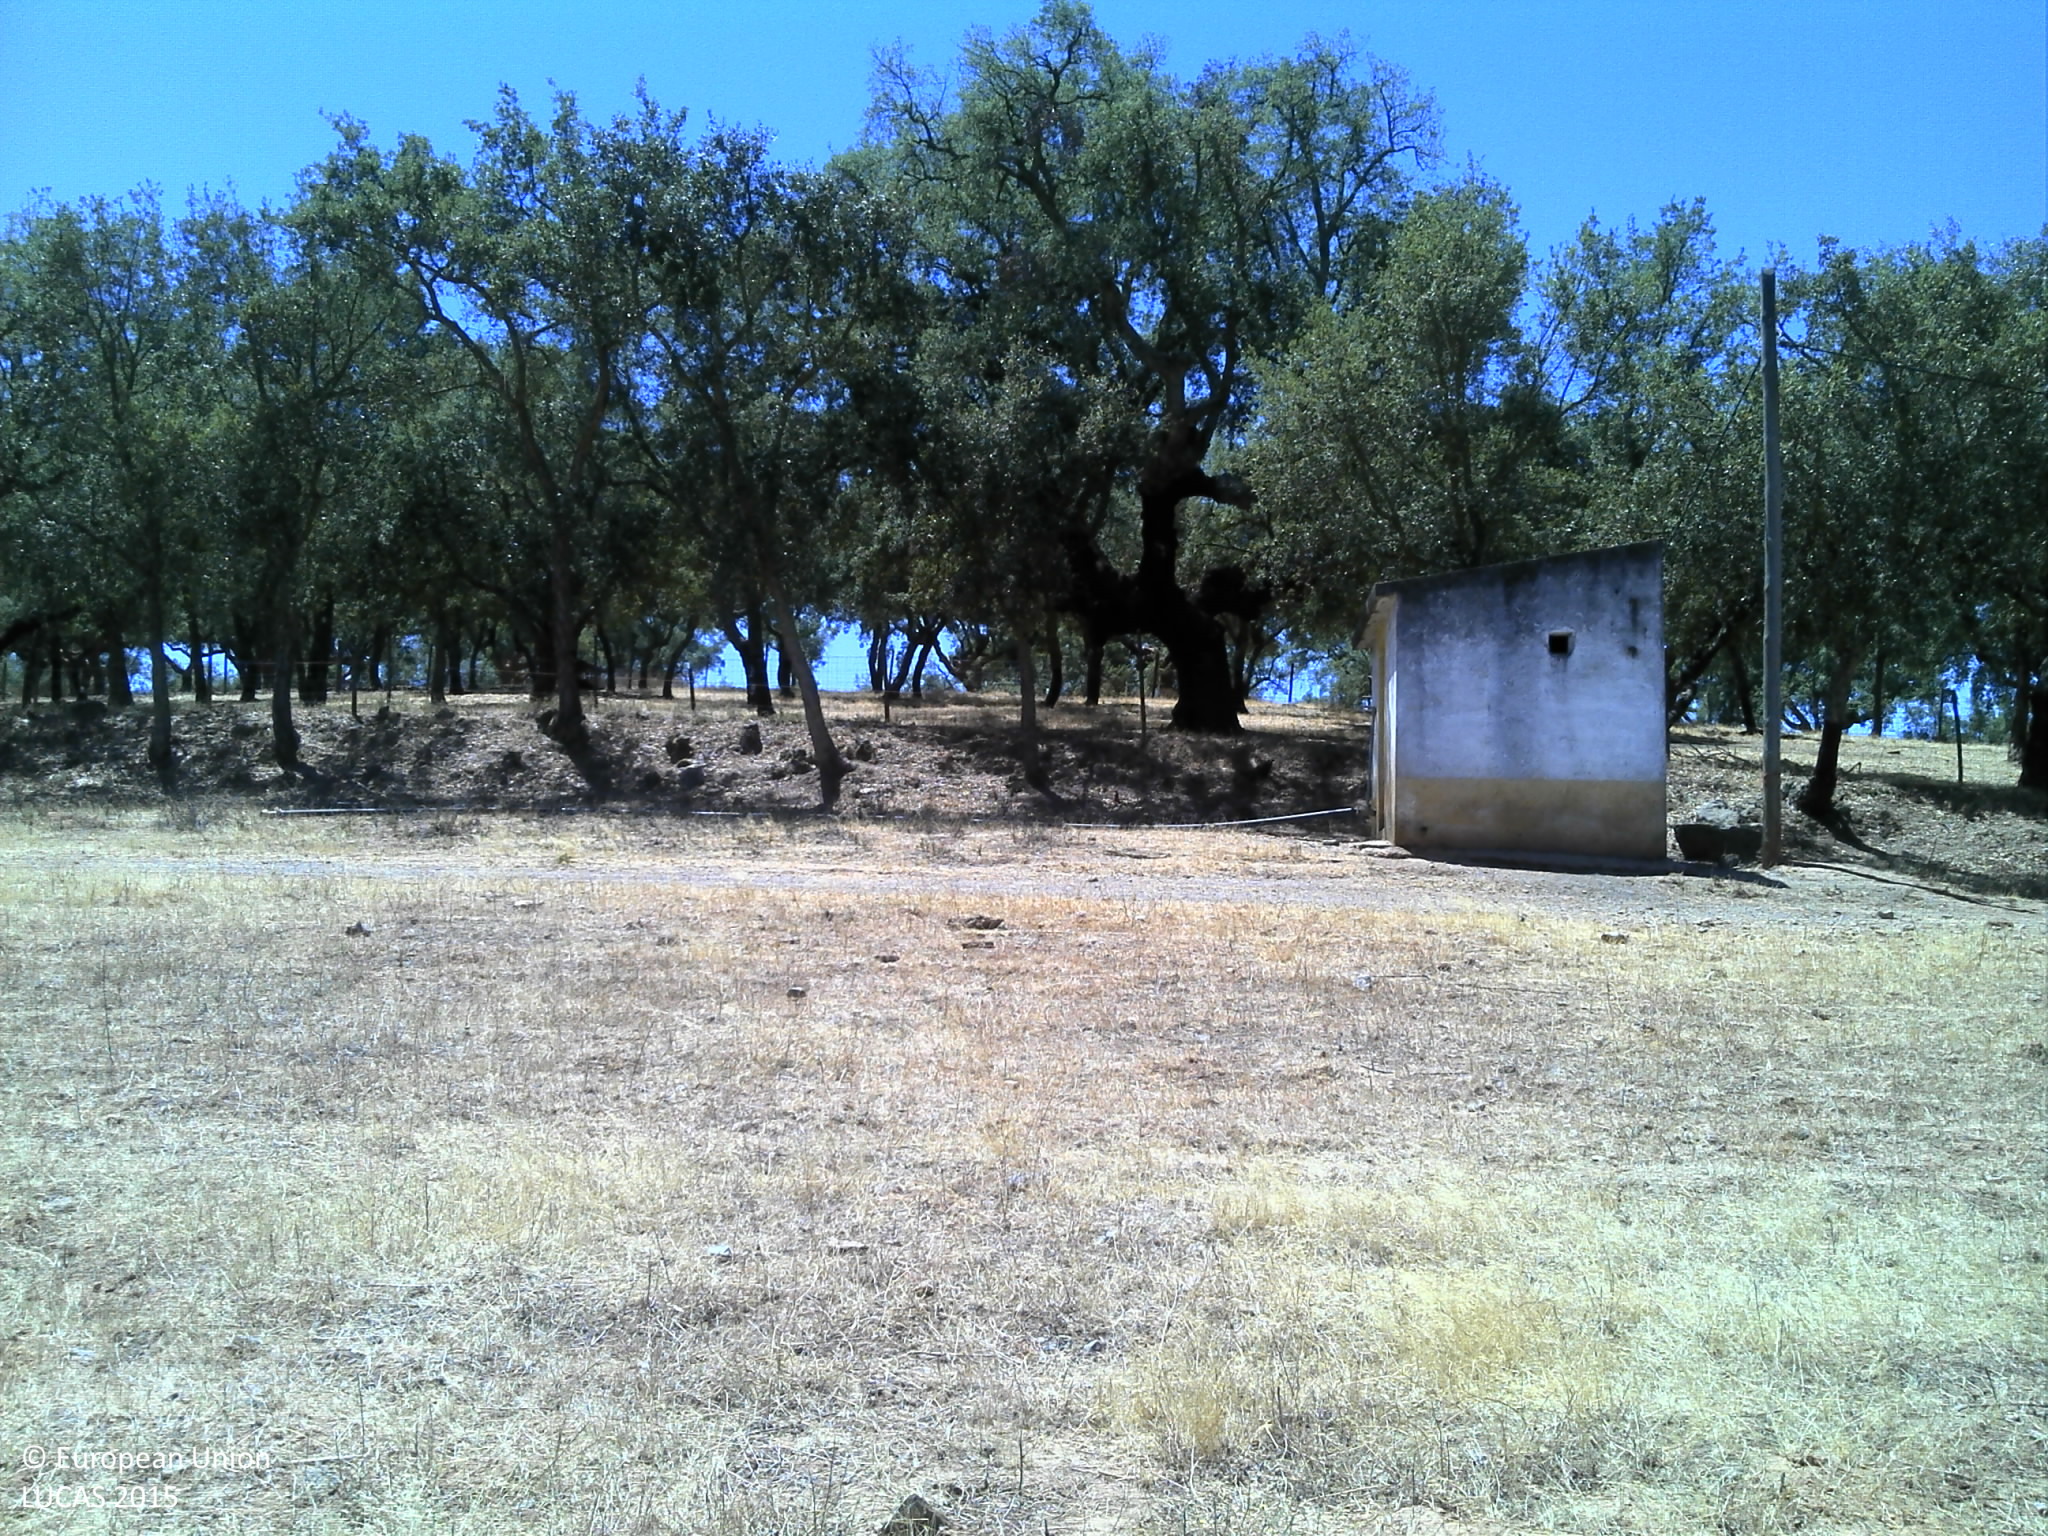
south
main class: Grassland
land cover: Grassland with sparse tree/shrub cover
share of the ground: 10 - 25 %
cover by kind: unconsolidated bare surface 70 %, herbaceous plants 25 %, broadleaved forest trees 5 %
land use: Agriculture (excluding fallow land and kitchen gardens)
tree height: > 5 m
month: July
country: PT
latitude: 38.8660
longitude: -7.4956
